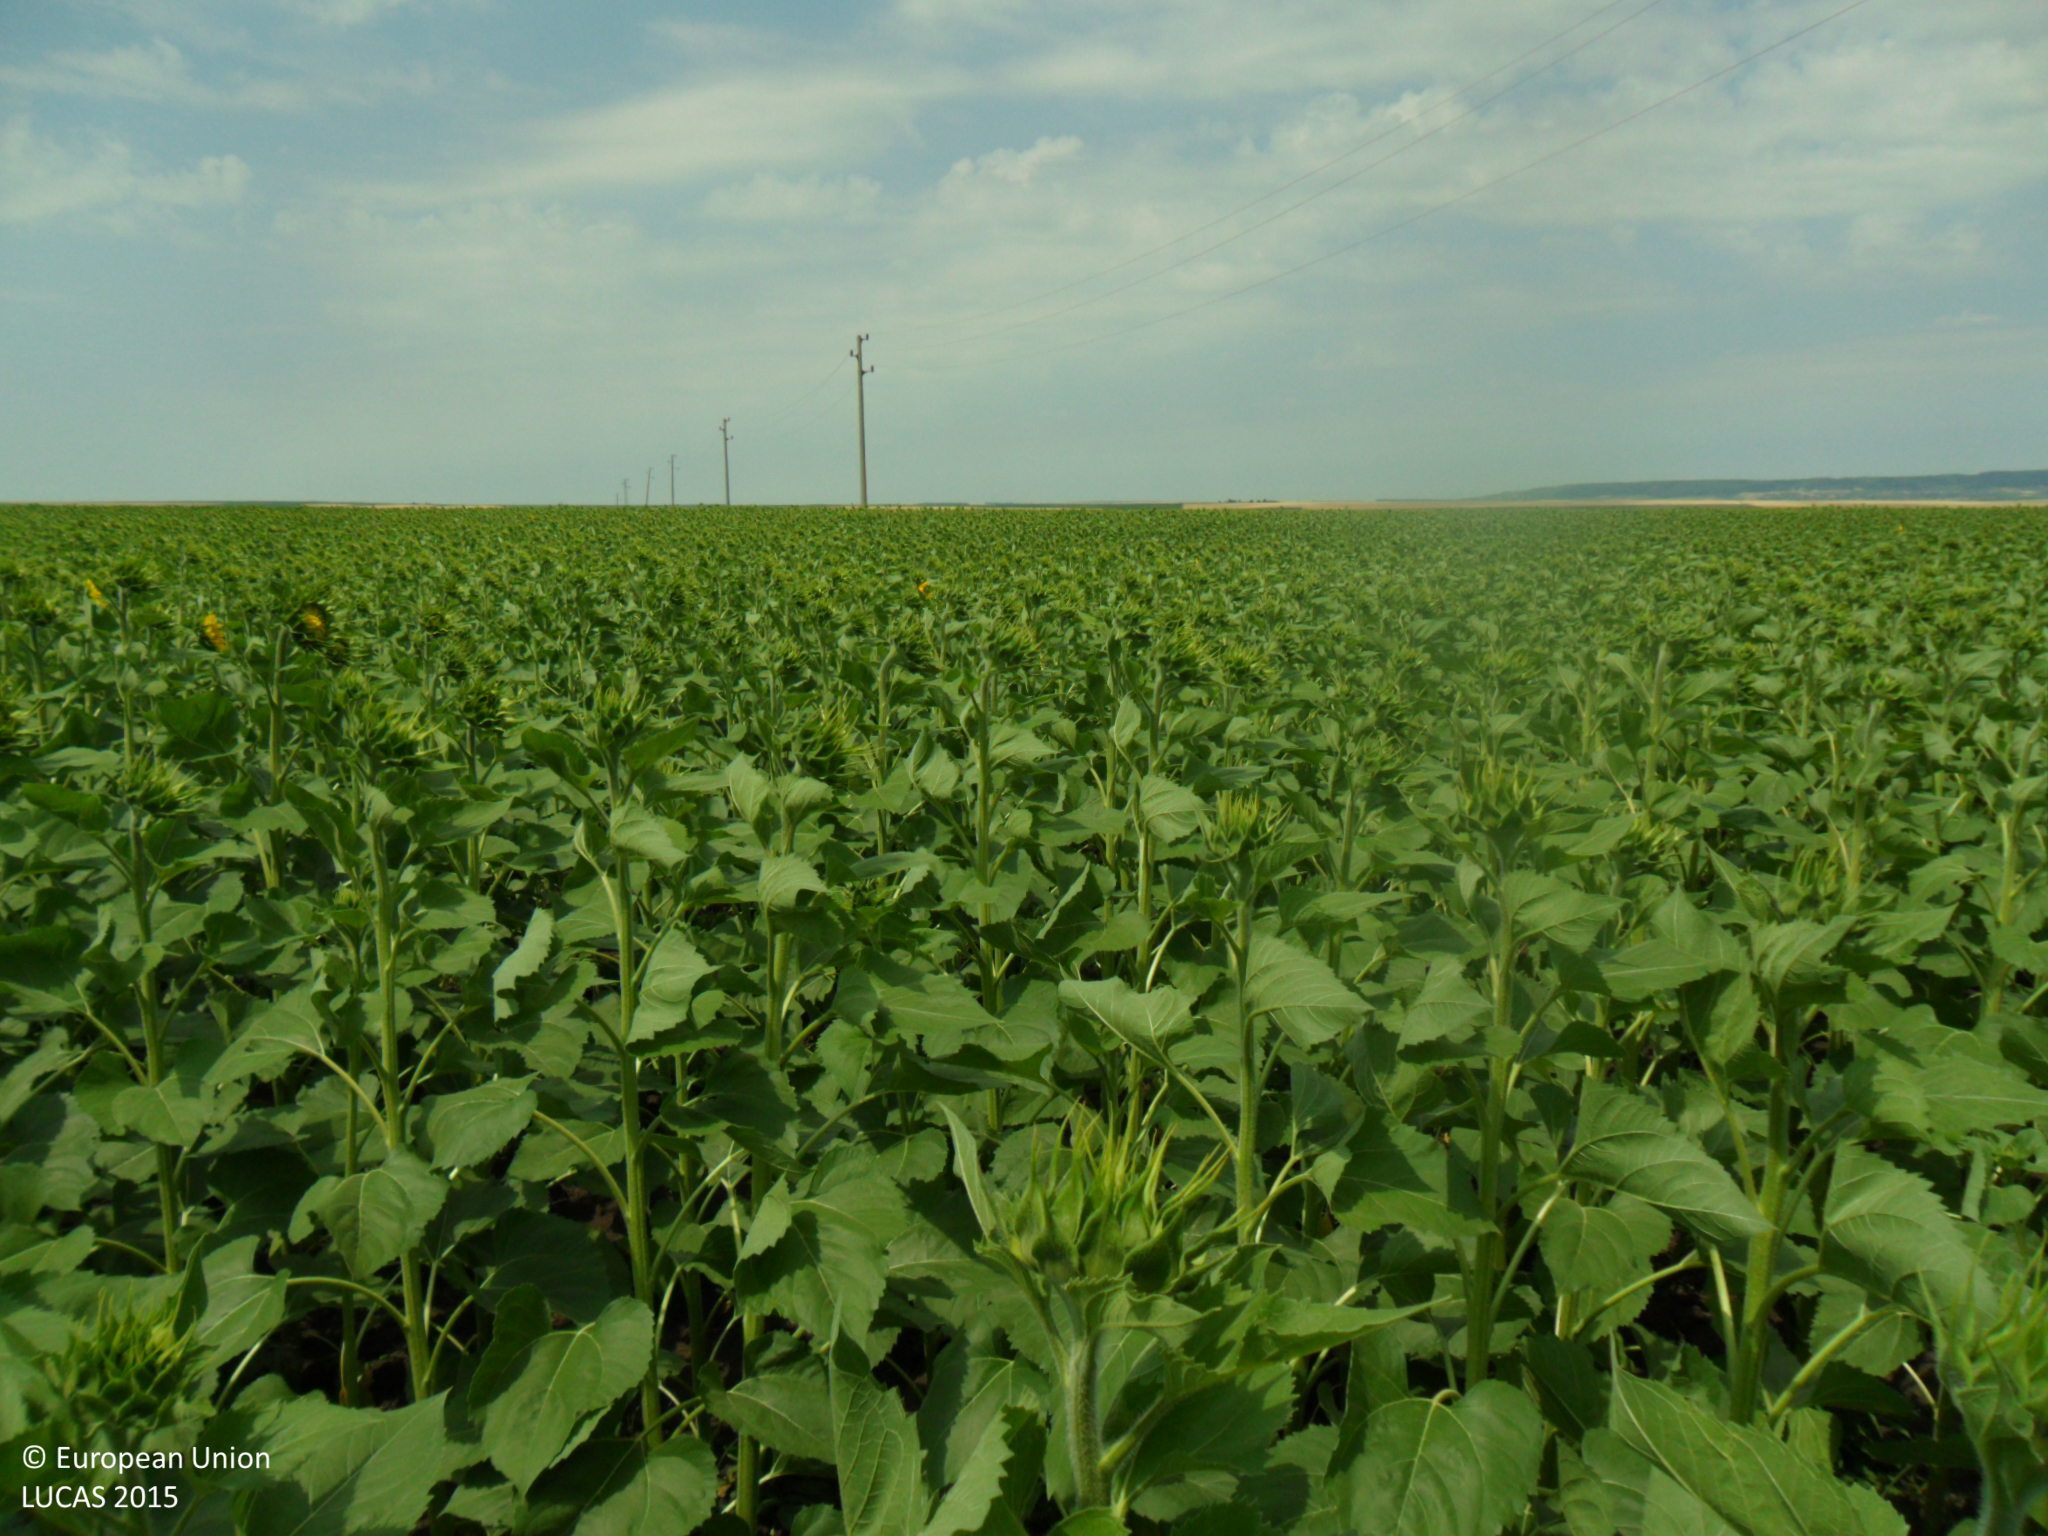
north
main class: Cropland
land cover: Sunflower
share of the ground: > 75 %
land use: Agriculture (excluding fallow land and kitchen gardens)
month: June
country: BG
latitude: 43.3654
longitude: 26.9589
